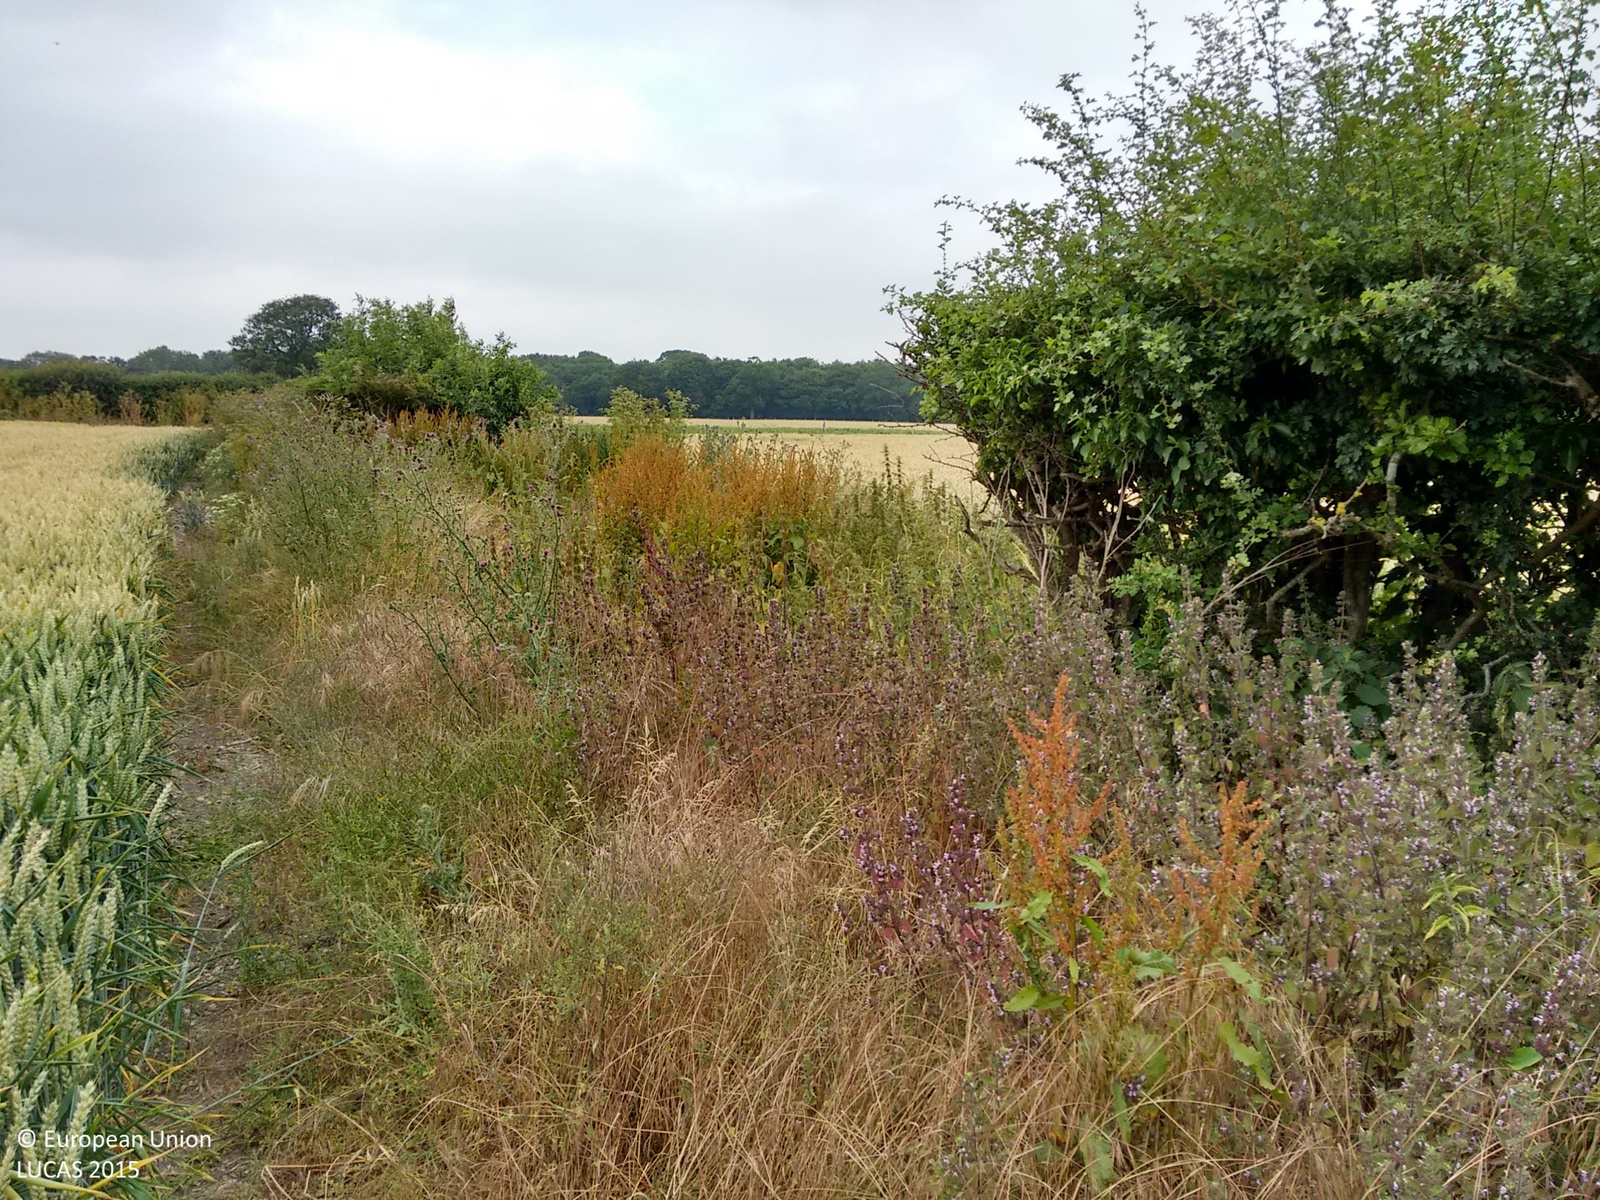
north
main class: Cropland
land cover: Common wheat
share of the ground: > 75 %
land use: Agriculture (excluding fallow land and kitchen gardens)
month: July
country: GB
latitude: 51.7615
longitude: -1.1301
